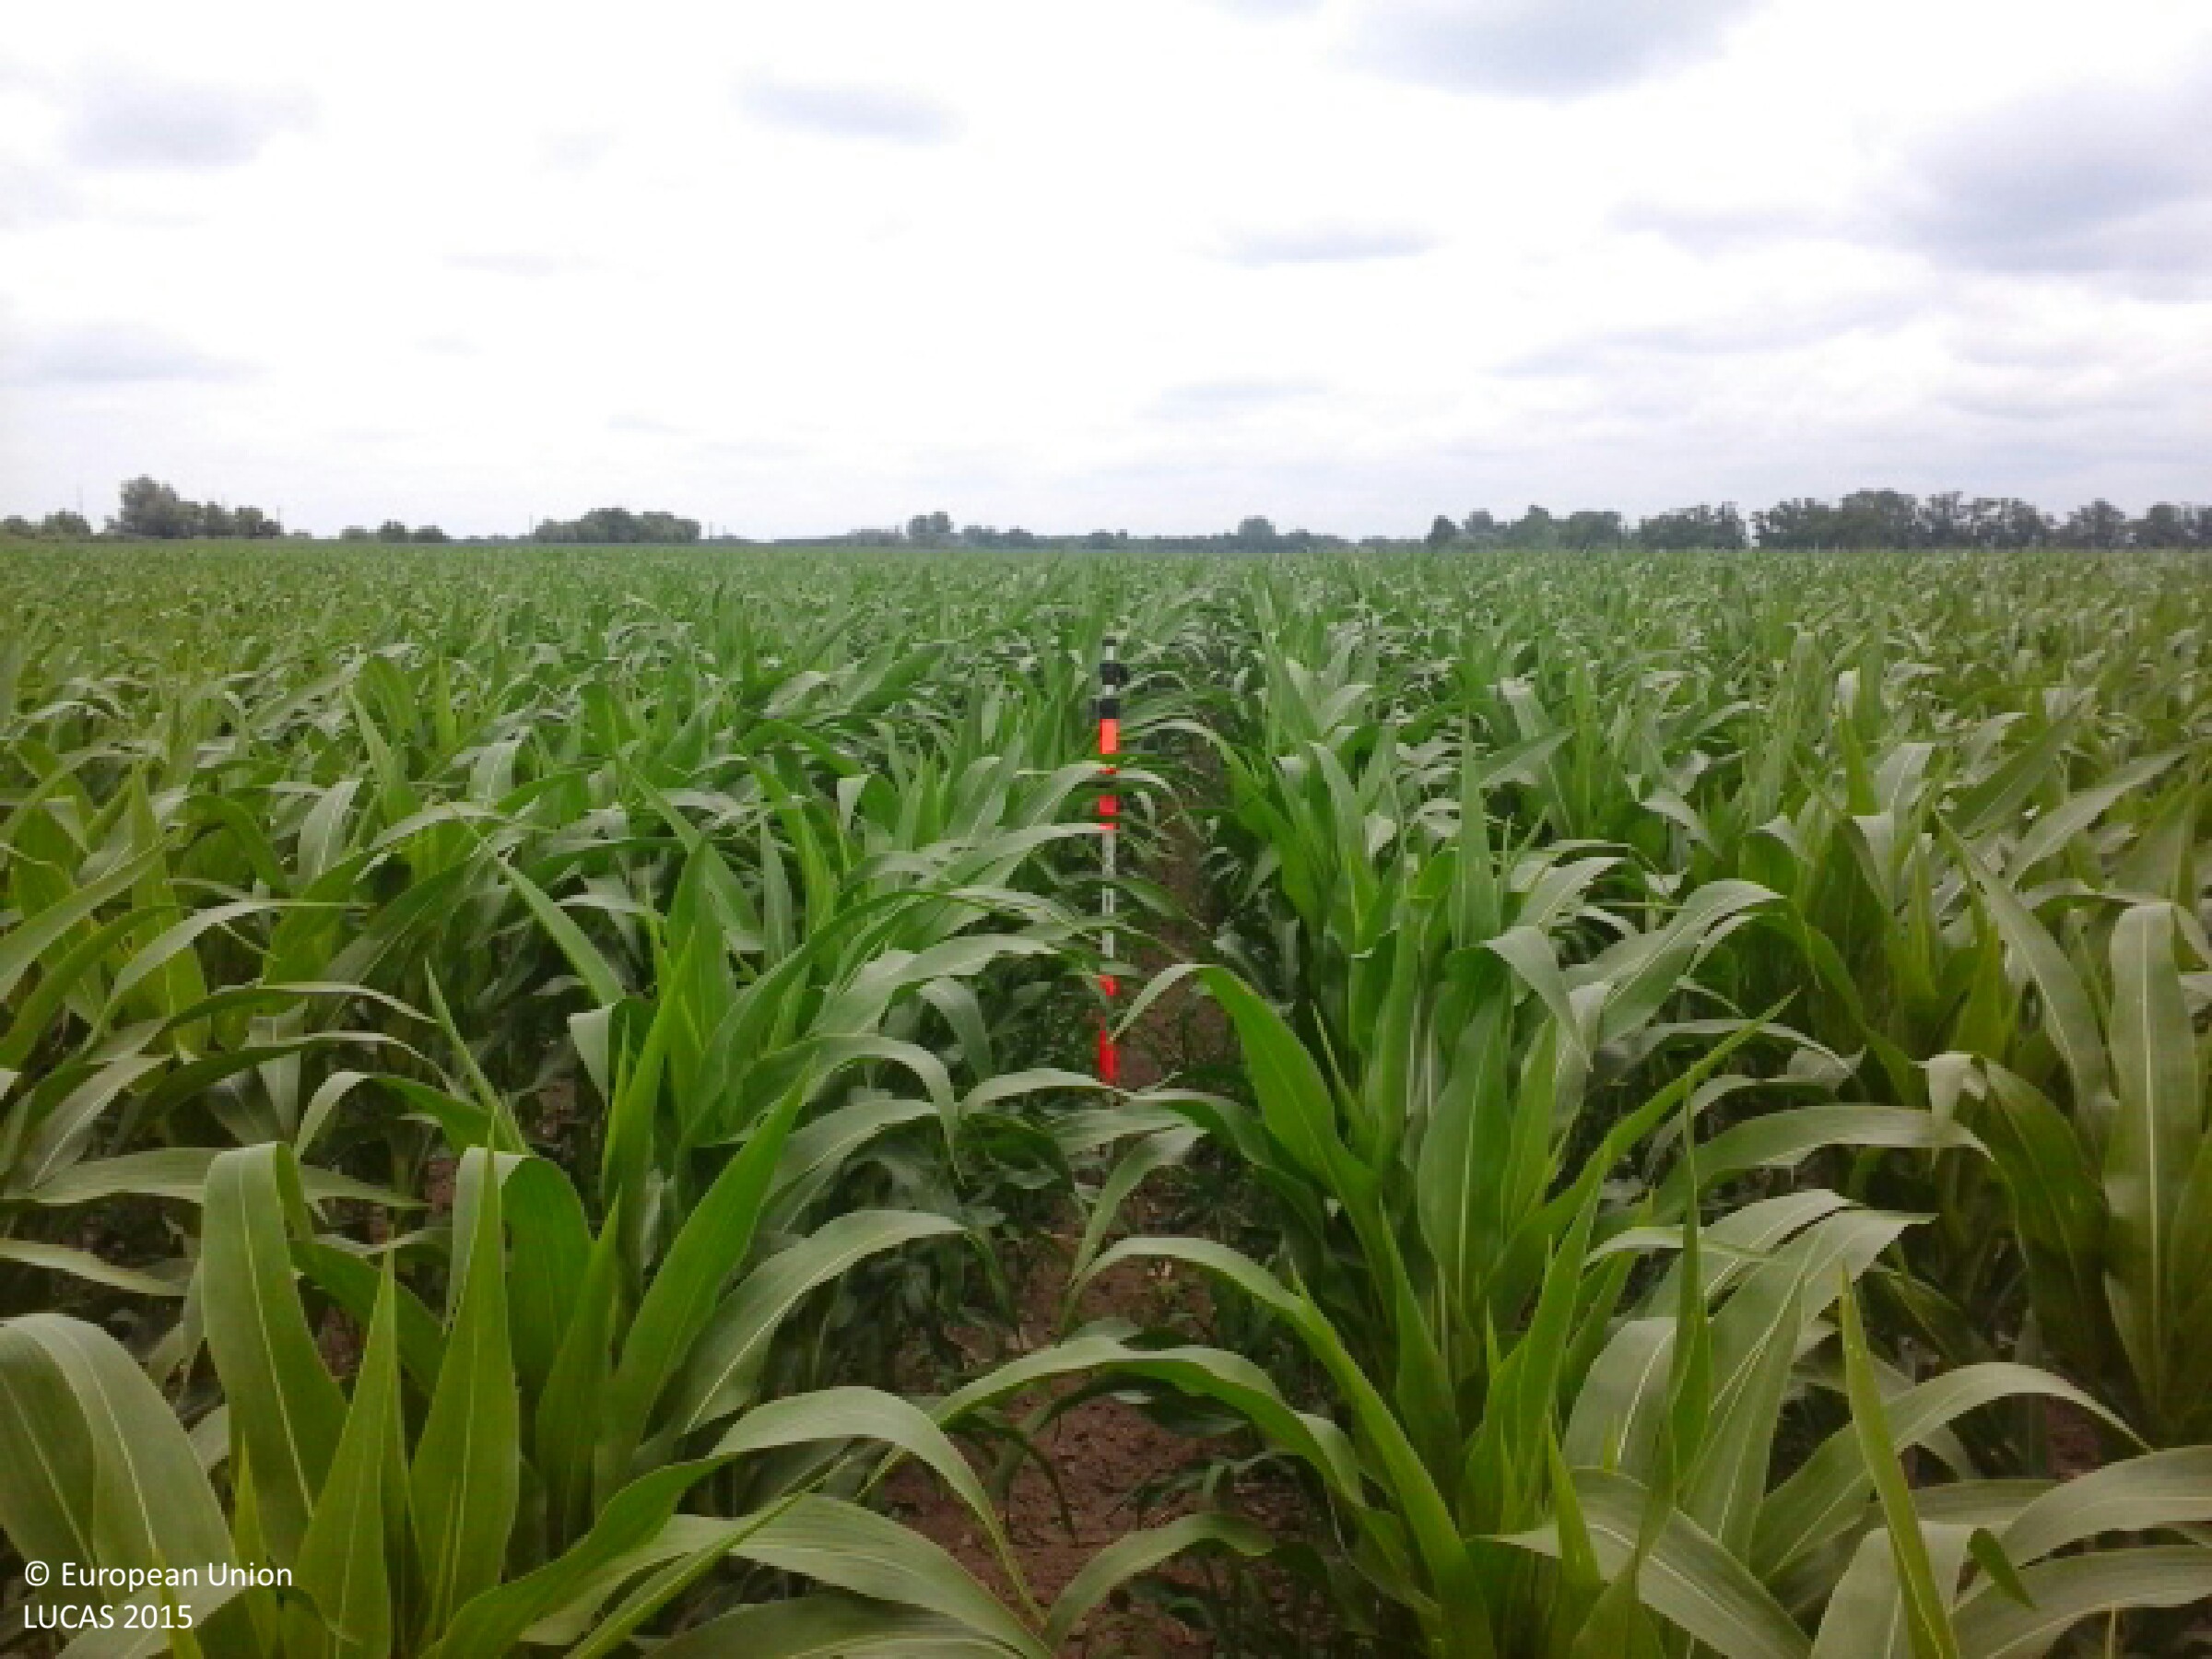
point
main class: Cropland
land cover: Maize
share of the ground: > 75 %
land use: Agriculture (excluding fallow land and kitchen gardens)
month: June
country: HU
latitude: 48.1675
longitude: 21.8154
